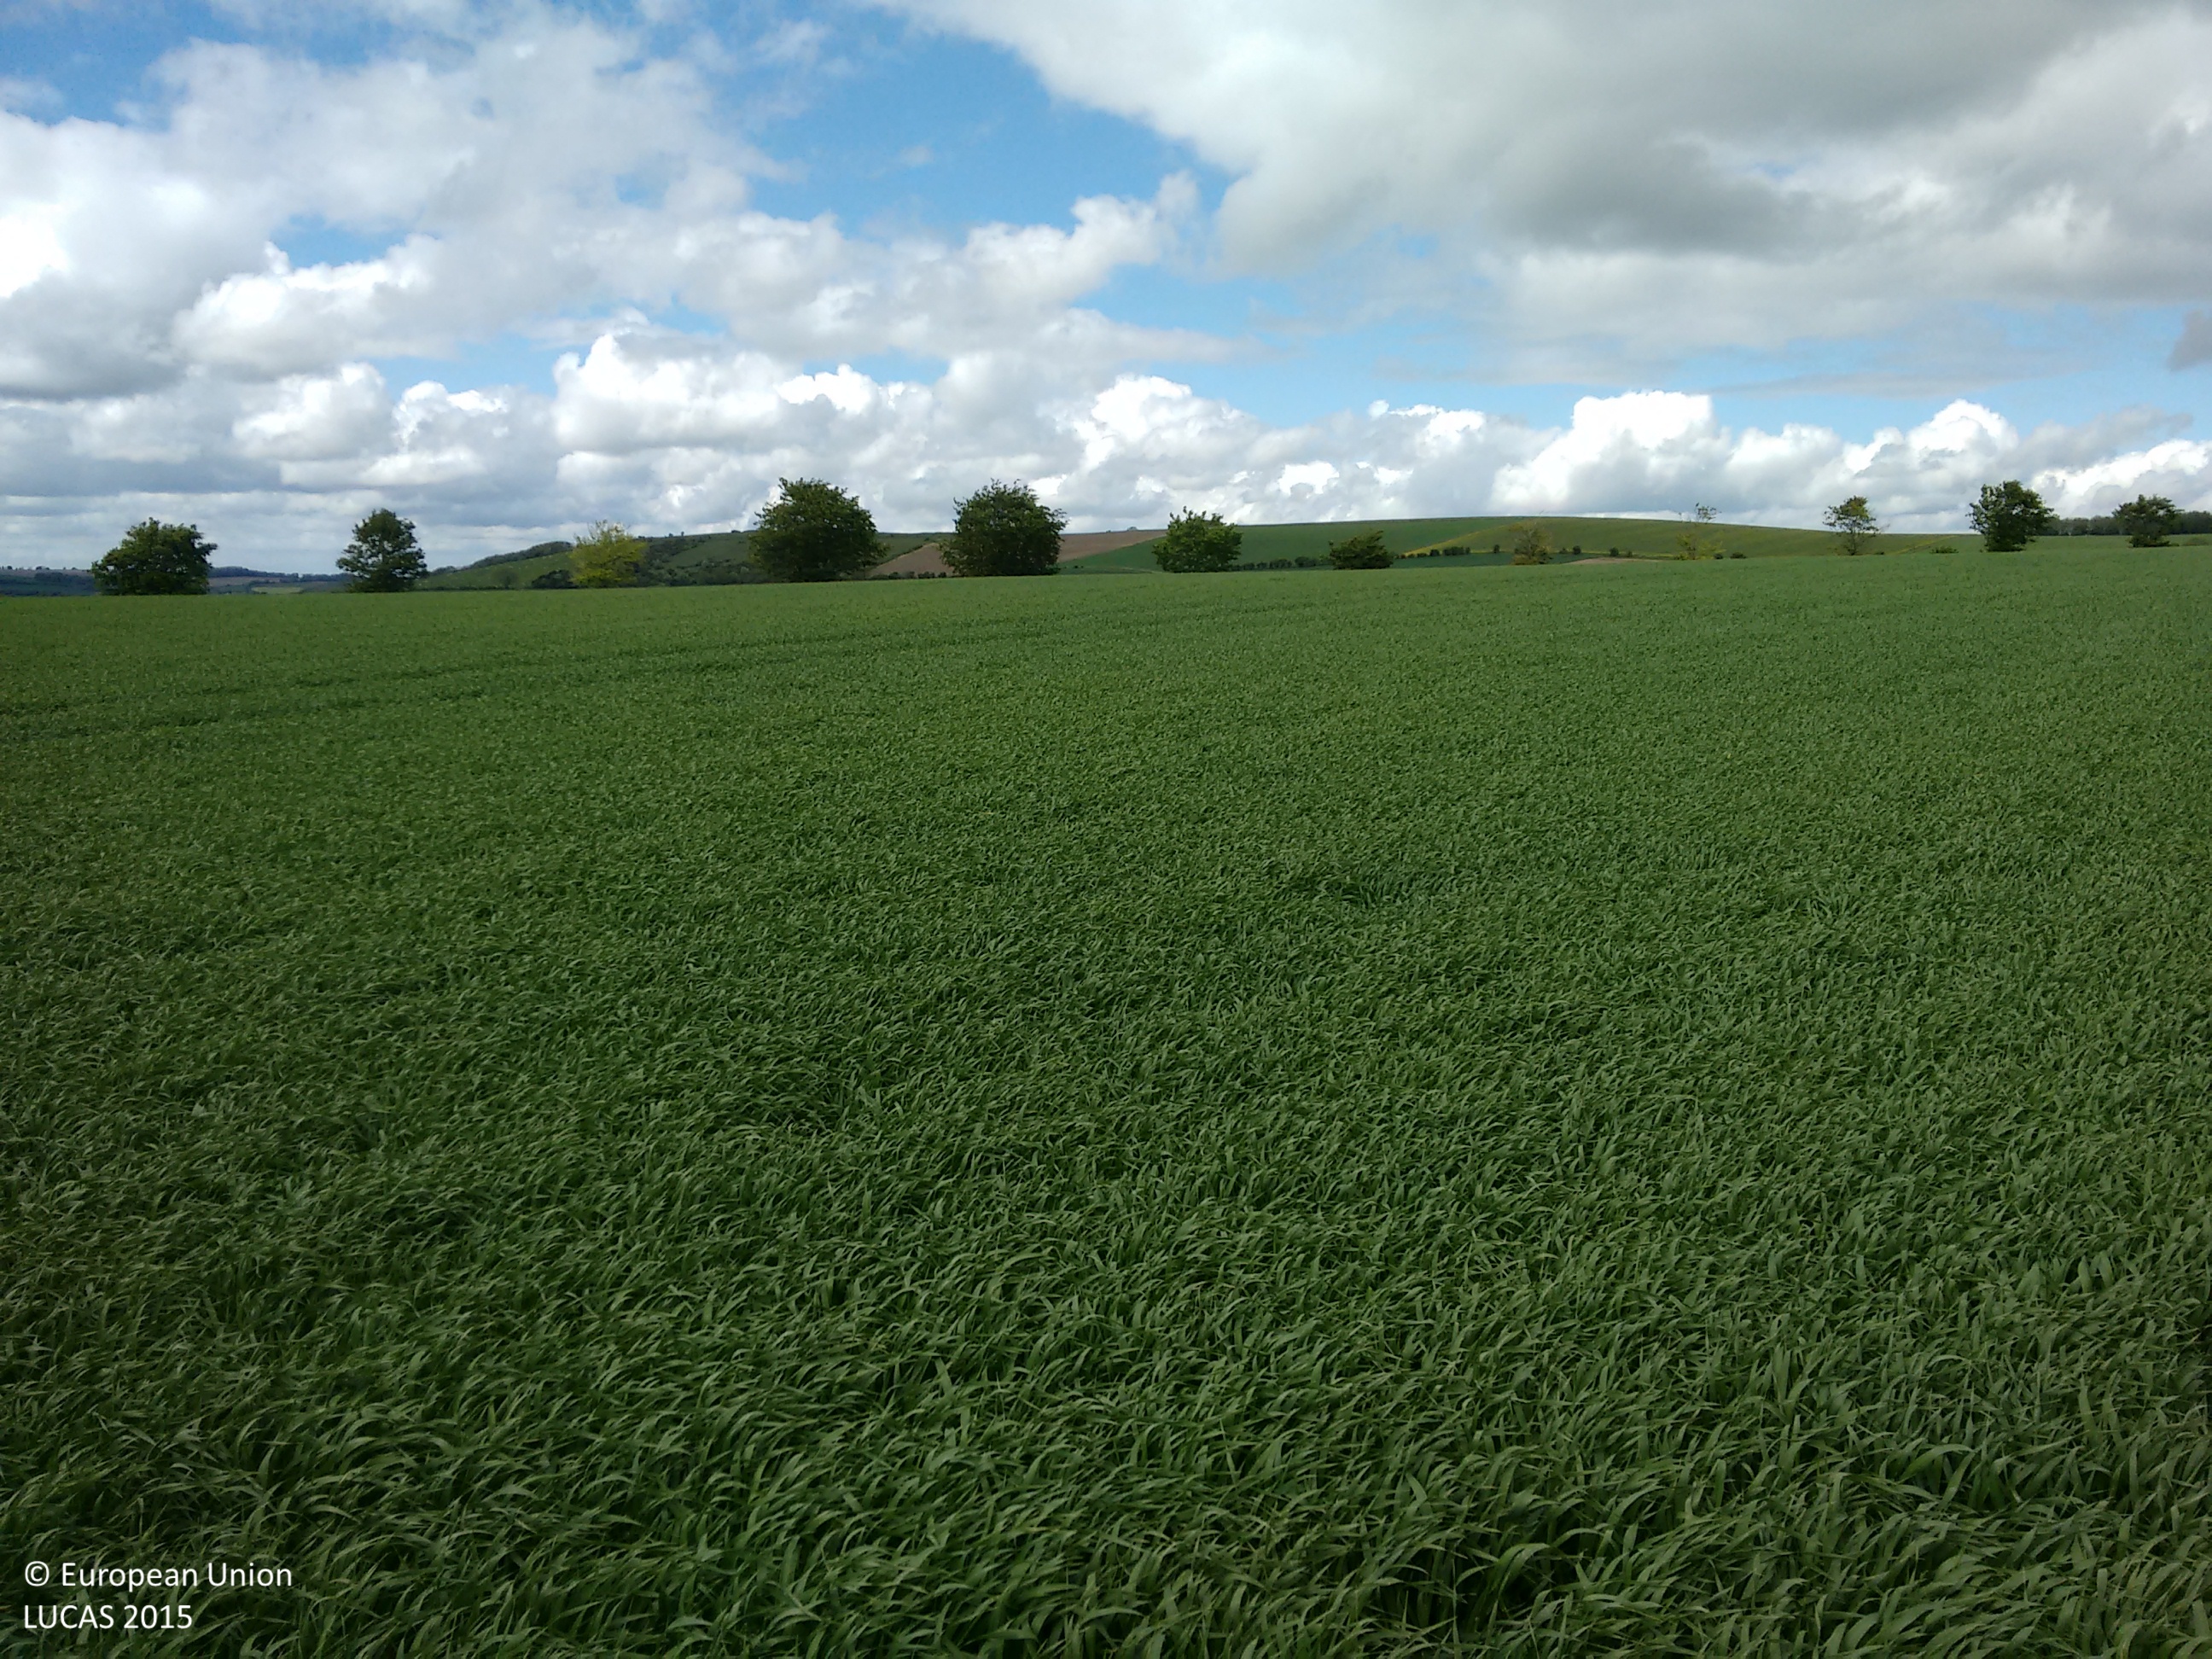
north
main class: Cropland
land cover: Barley
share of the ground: > 75 %
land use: Agriculture (excluding fallow land and kitchen gardens)
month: May
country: GB
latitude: 50.9674
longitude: -1.0812
